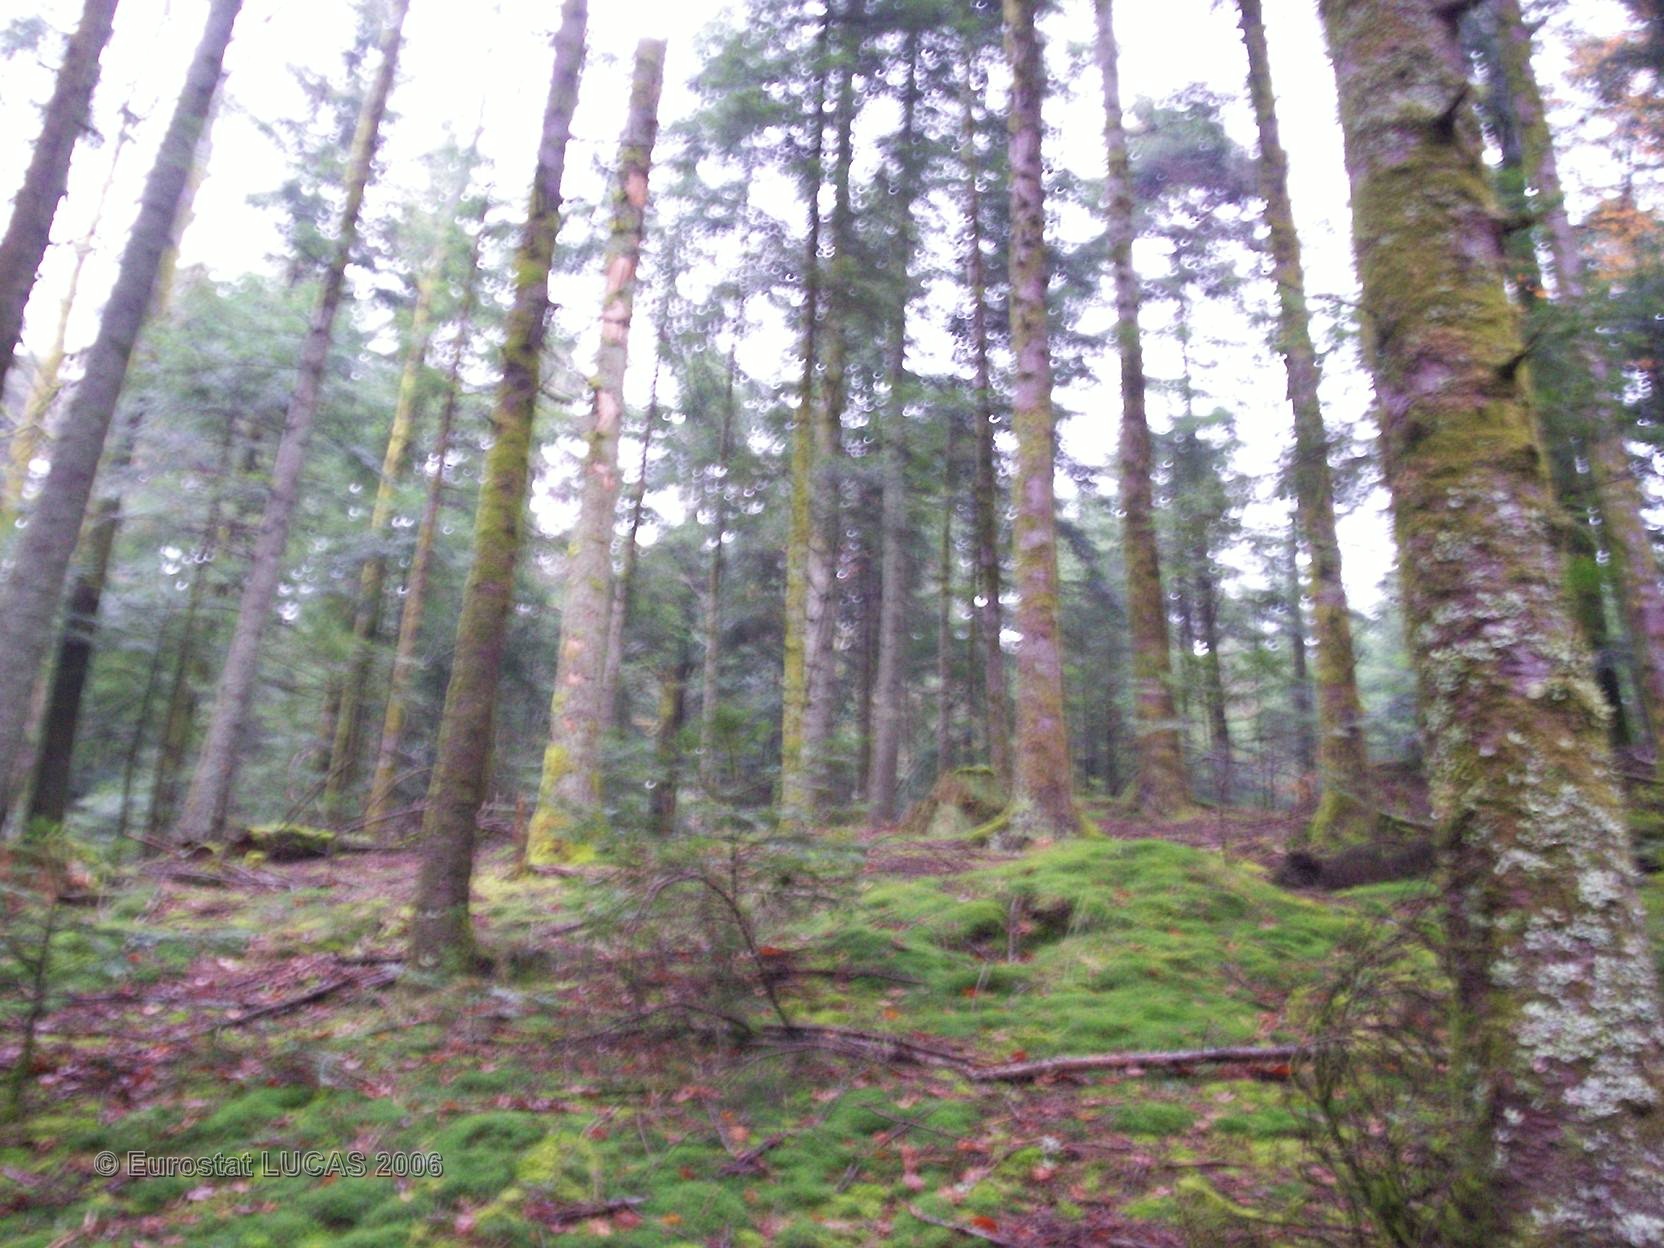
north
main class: Woodland
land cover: Coniferous forest
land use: Forestry
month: April
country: FR
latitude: 47.9897
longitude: 6.5572
